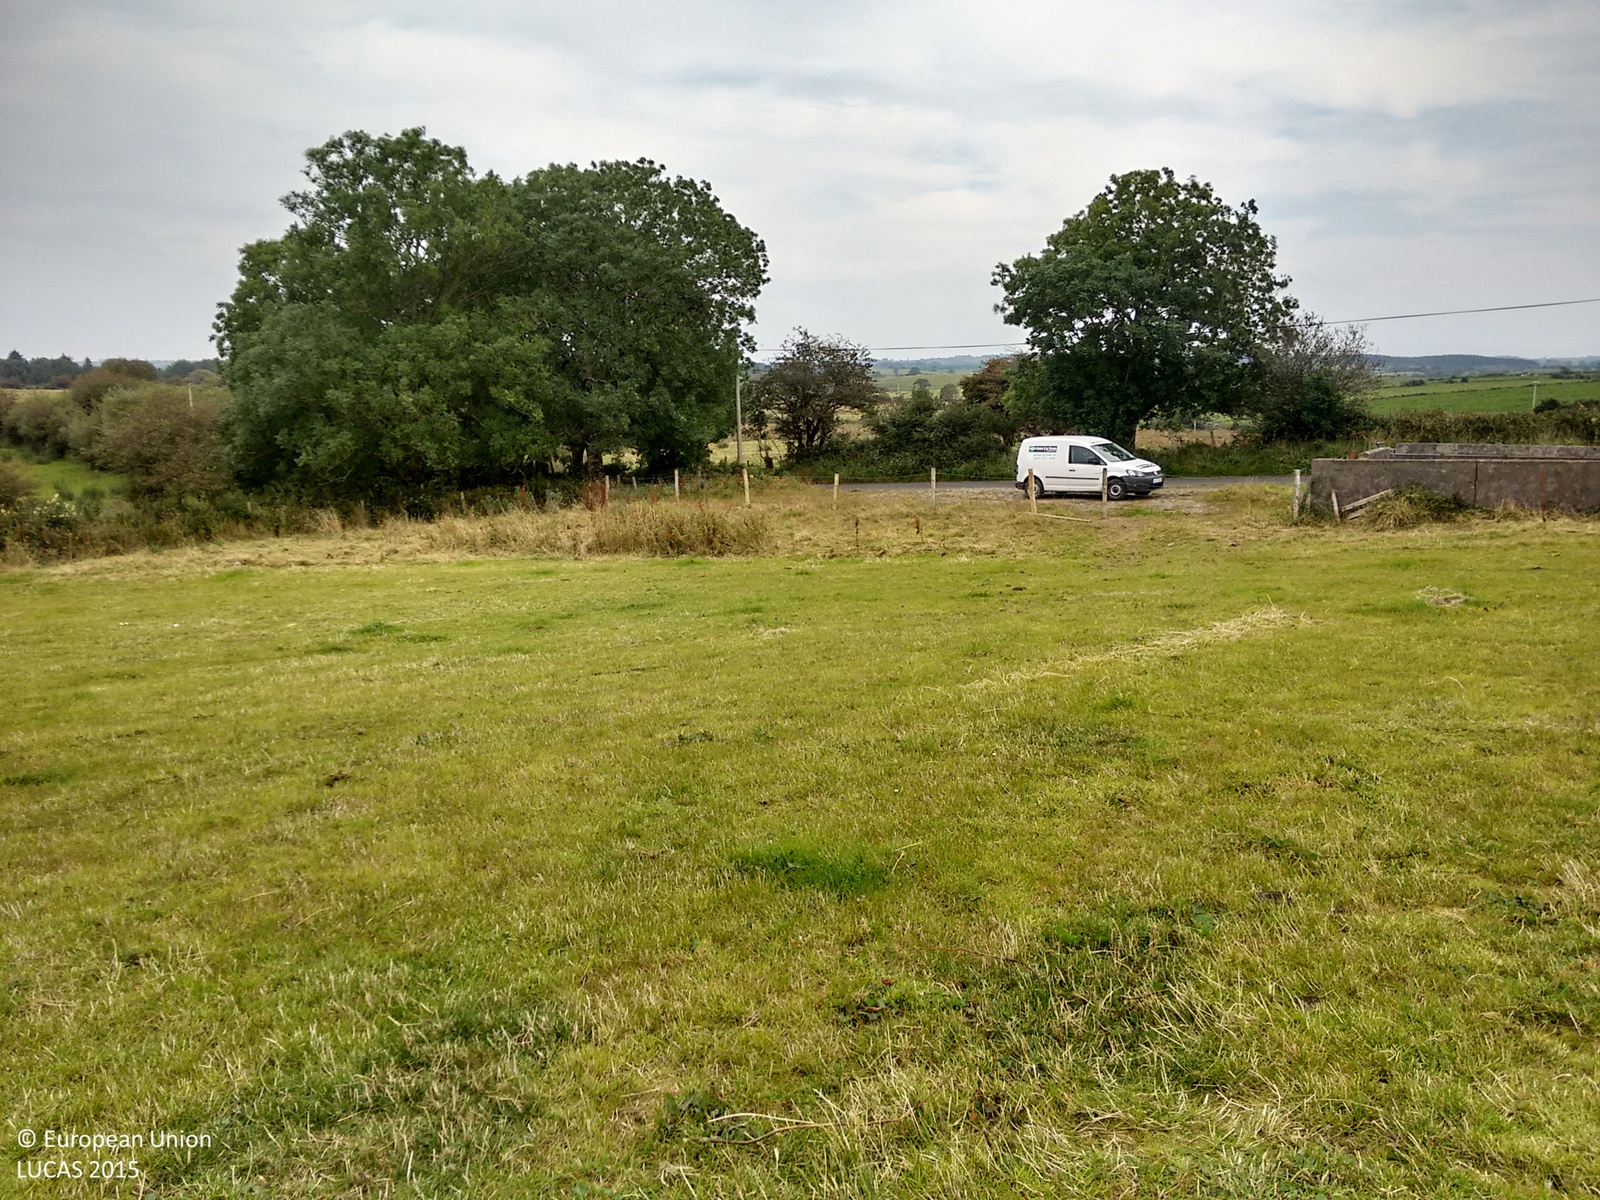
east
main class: Grassland
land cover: Grassland without tree/shrub cover
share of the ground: > 75 %
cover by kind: herbaceous plants 100 %
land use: Agriculture (excluding fallow land and kitchen gardens)
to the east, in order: Grassland without tree/shrub cover; Ditches and canals; Grassland without tree/shrub cover; Fences; Broadleaved woodland; Grassland without tree/shrub cover
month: September
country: IE
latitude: 54.1977
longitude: -9.3073
